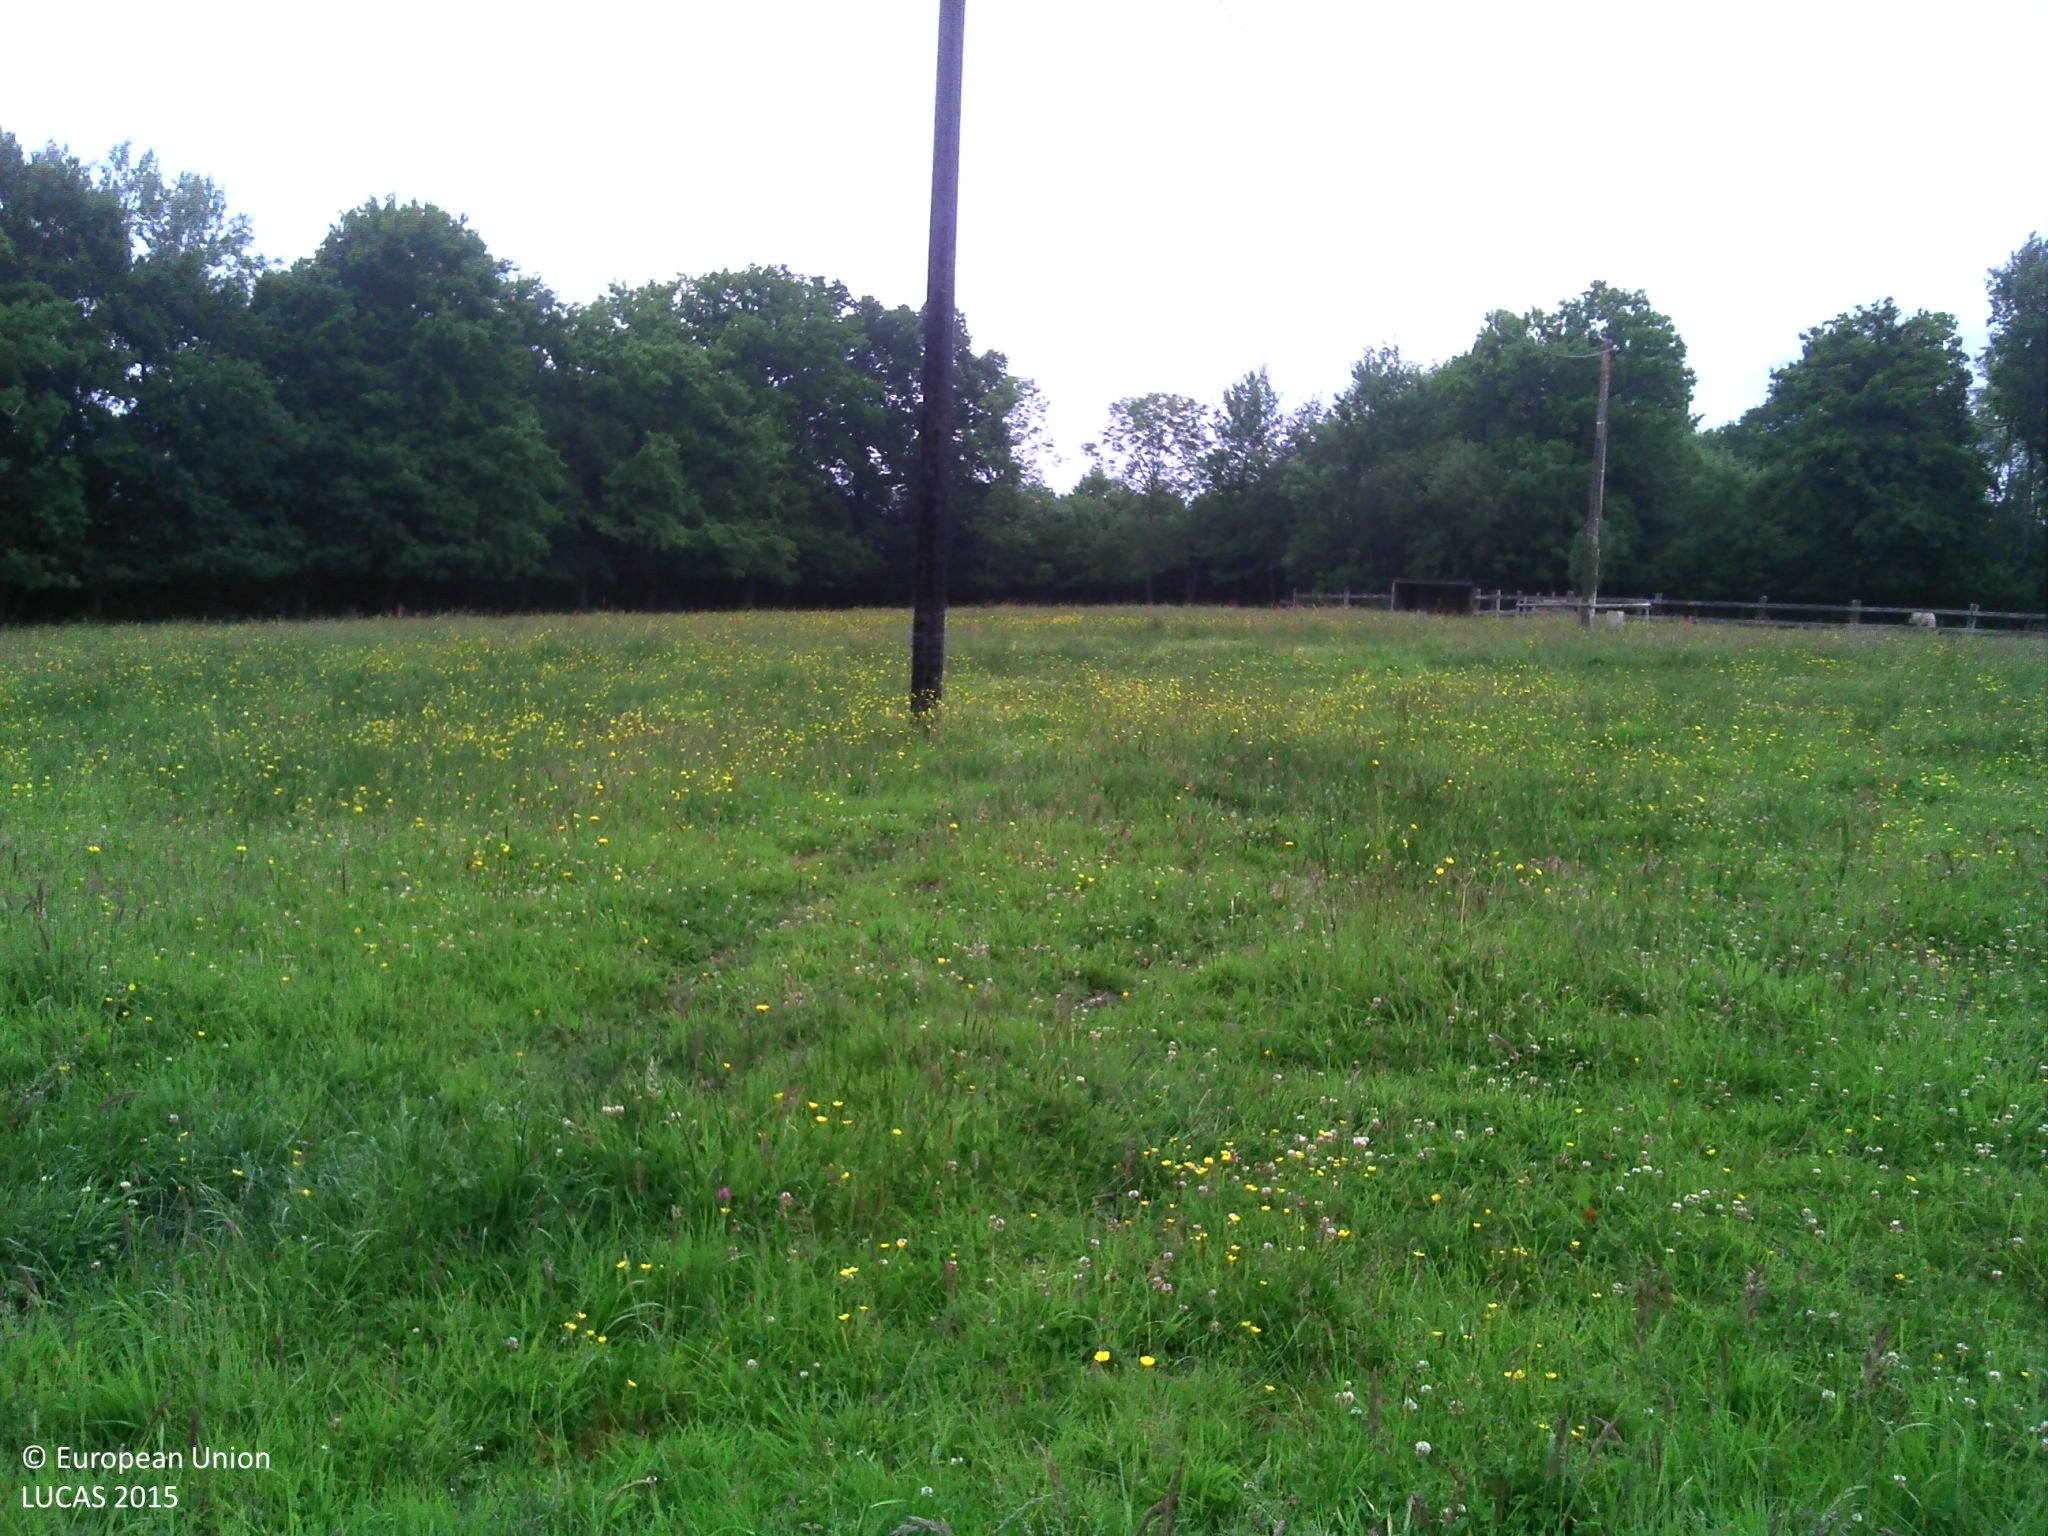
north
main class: Grassland
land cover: Grassland without tree/shrub cover
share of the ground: > 75 %
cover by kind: herbaceous plants 100 %
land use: Agriculture (excluding fallow land and kitchen gardens)
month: June
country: FR
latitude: 49.2347
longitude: -0.0157
